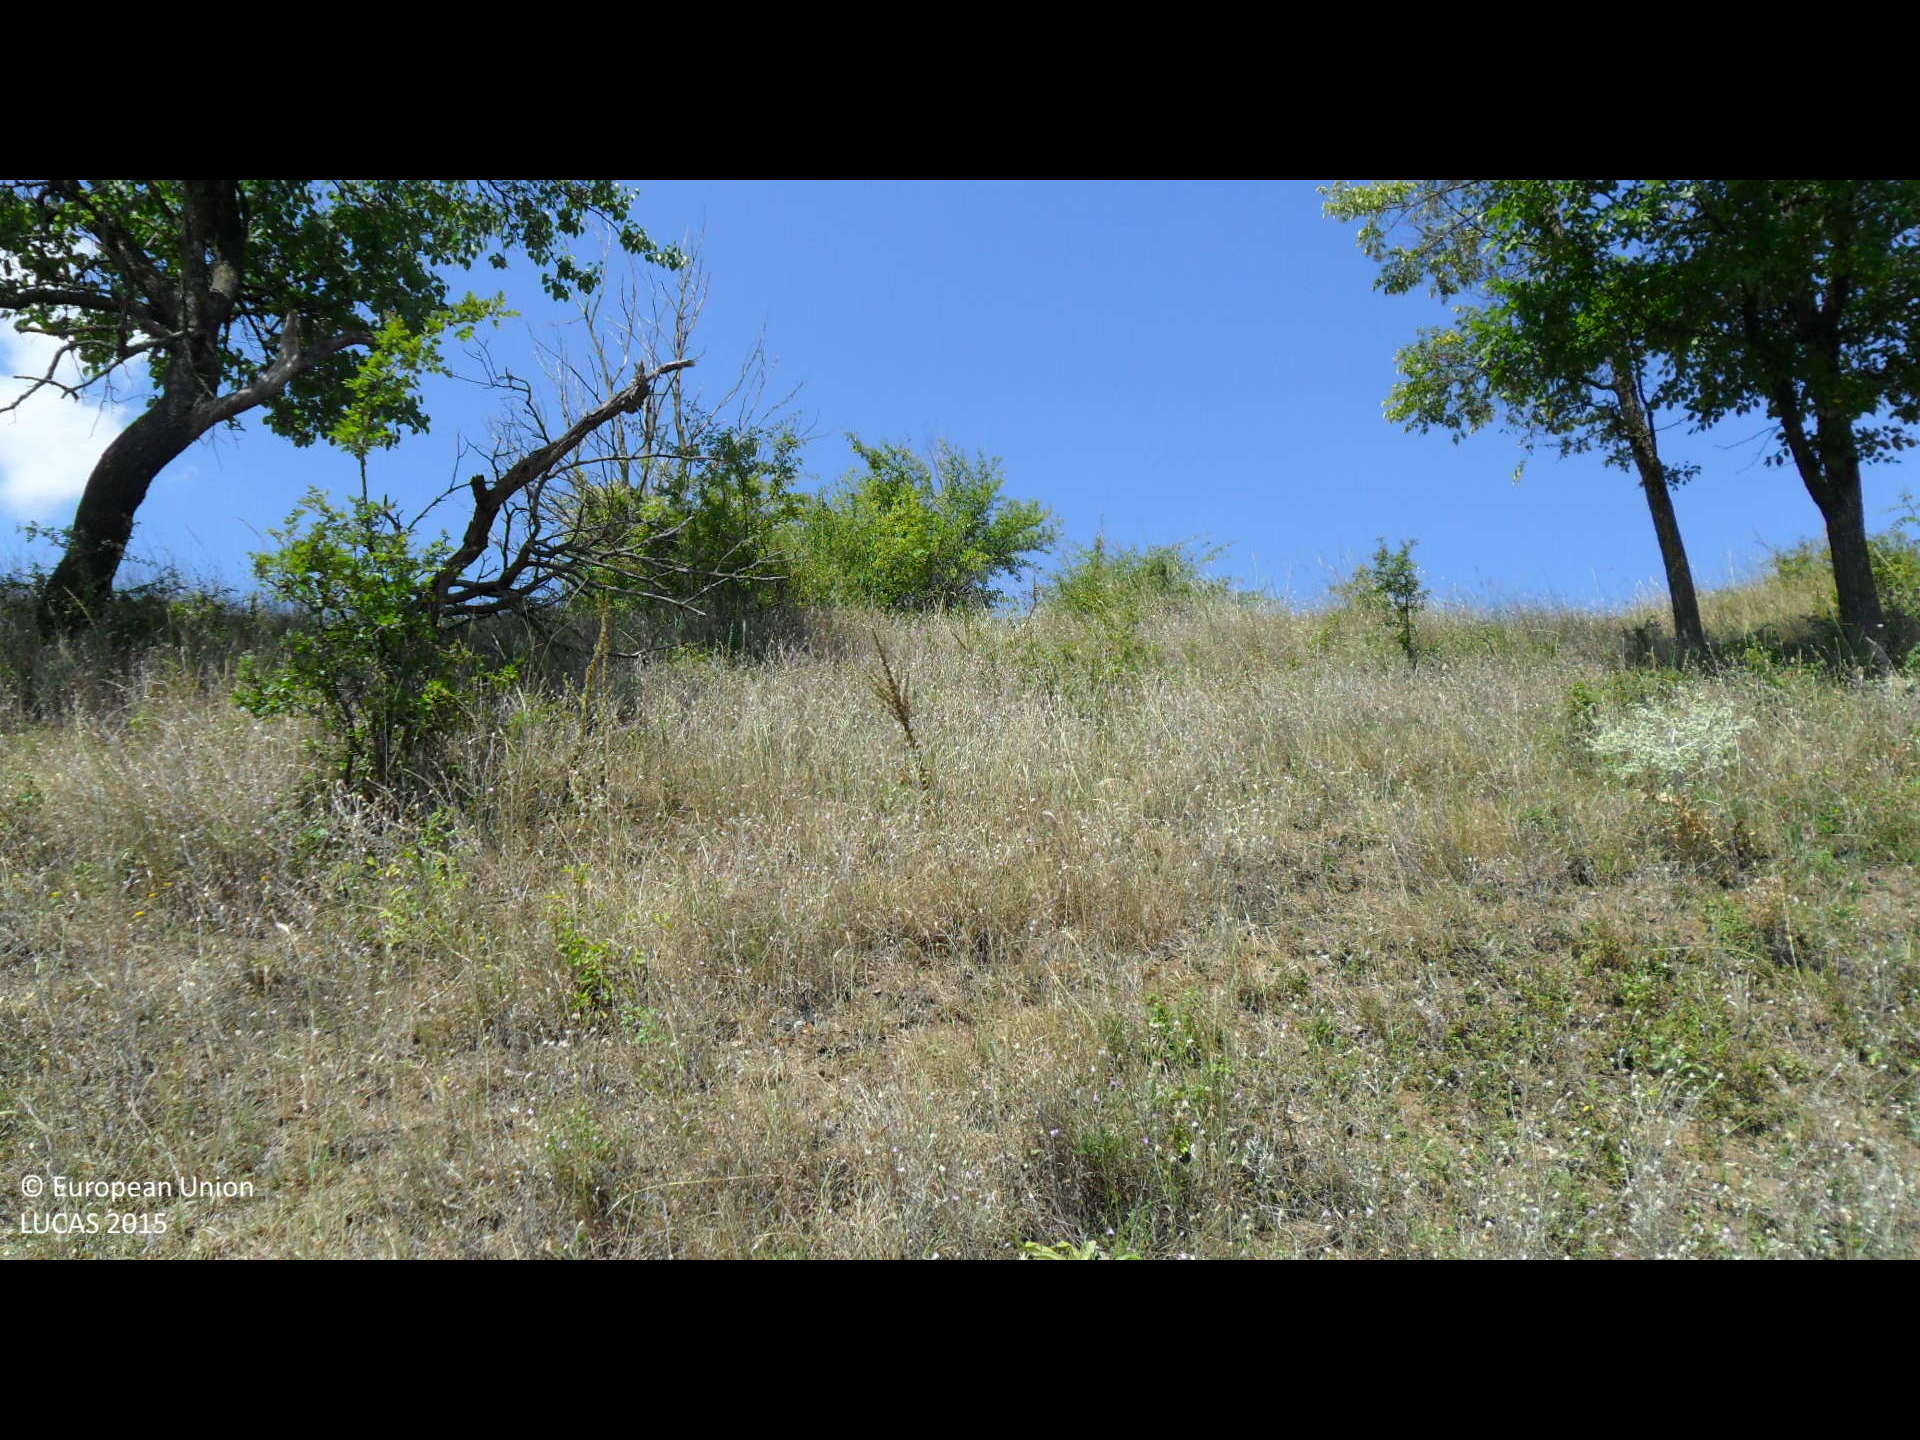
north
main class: Grassland
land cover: Grassland with sparse tree/shrub cover
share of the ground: > 75 %
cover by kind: herbaceous plants 90 %, broadleaved forest trees 5 %, shrubs 5 %
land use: Agriculture (excluding fallow land and kitchen gardens)
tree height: < 5 m
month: August
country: BG
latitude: 43.4357
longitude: 26.4221
